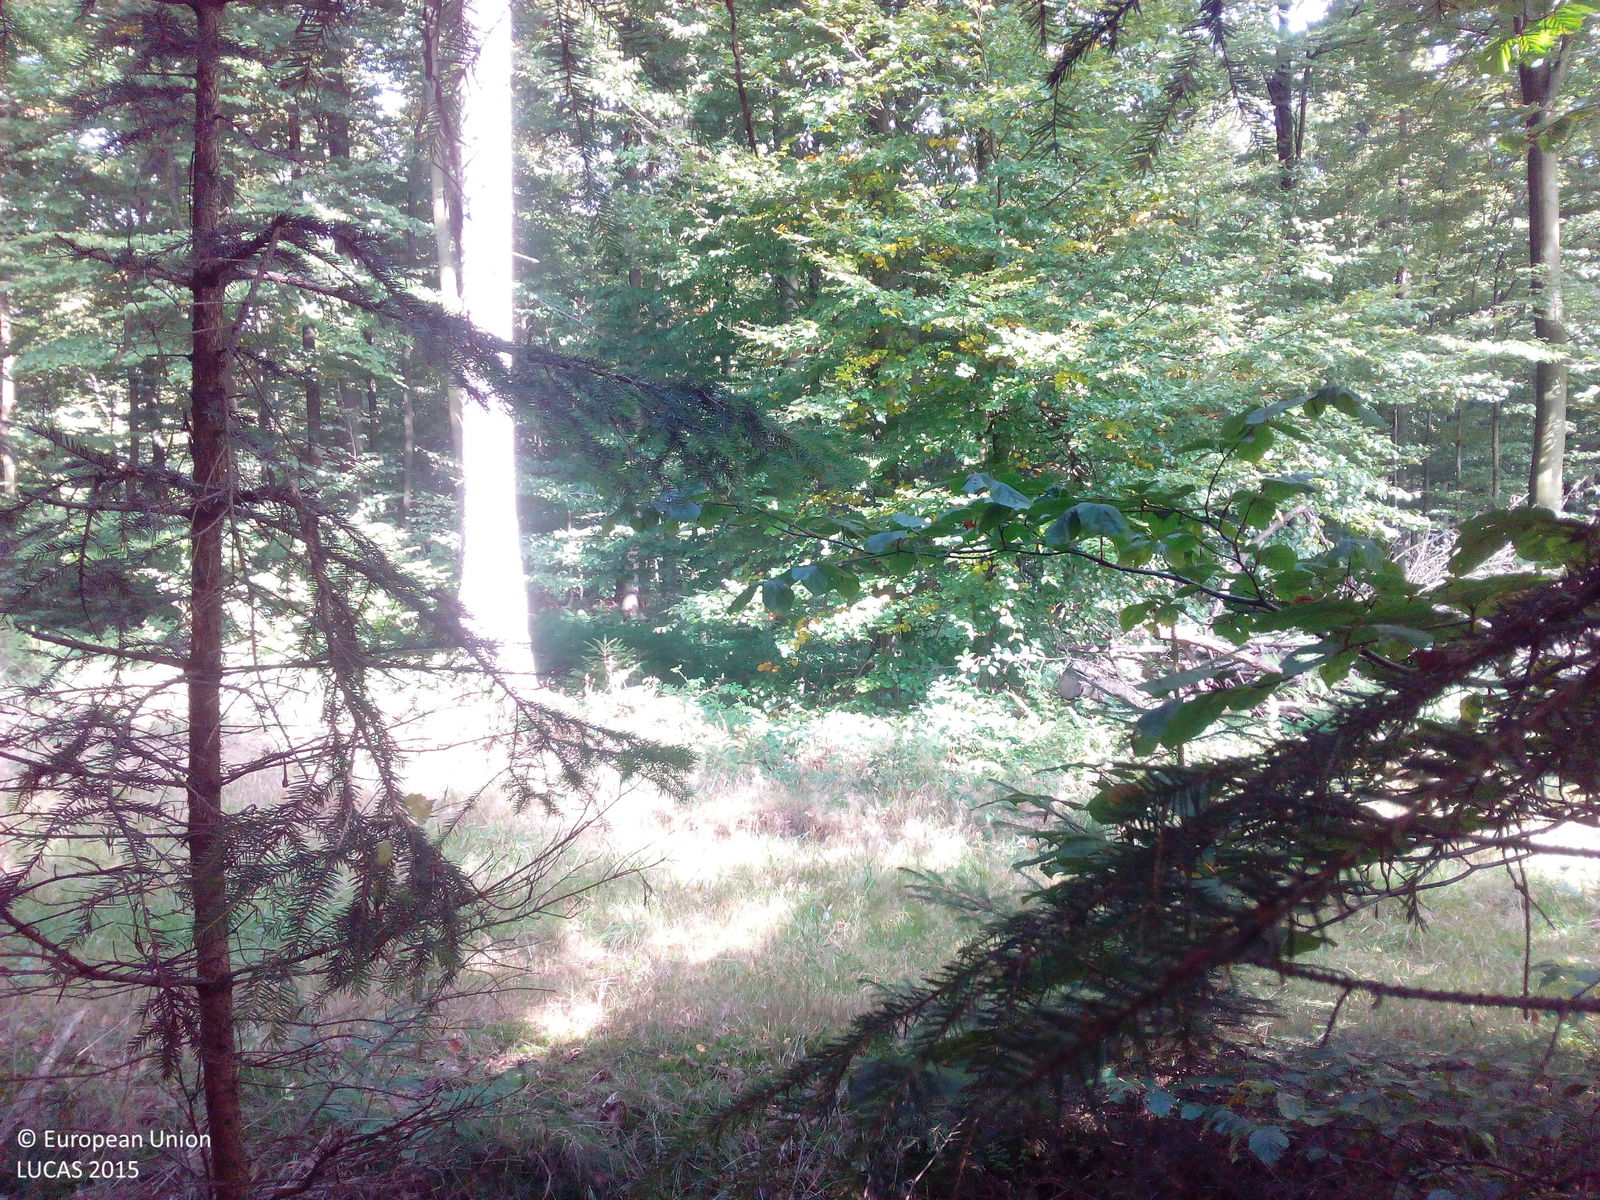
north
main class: Woodland
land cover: Spruce dominated coniferous woodland
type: hemiboreal forest and nemoral coniferous forest and mixed broadleaved-coniferous forest
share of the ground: > 75 %
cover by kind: coniferous forest trees 90 %, broadleaved forest trees 10 %
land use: Forestry
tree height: > 5 m
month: September
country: DE
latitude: 51.7837
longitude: 9.6377
